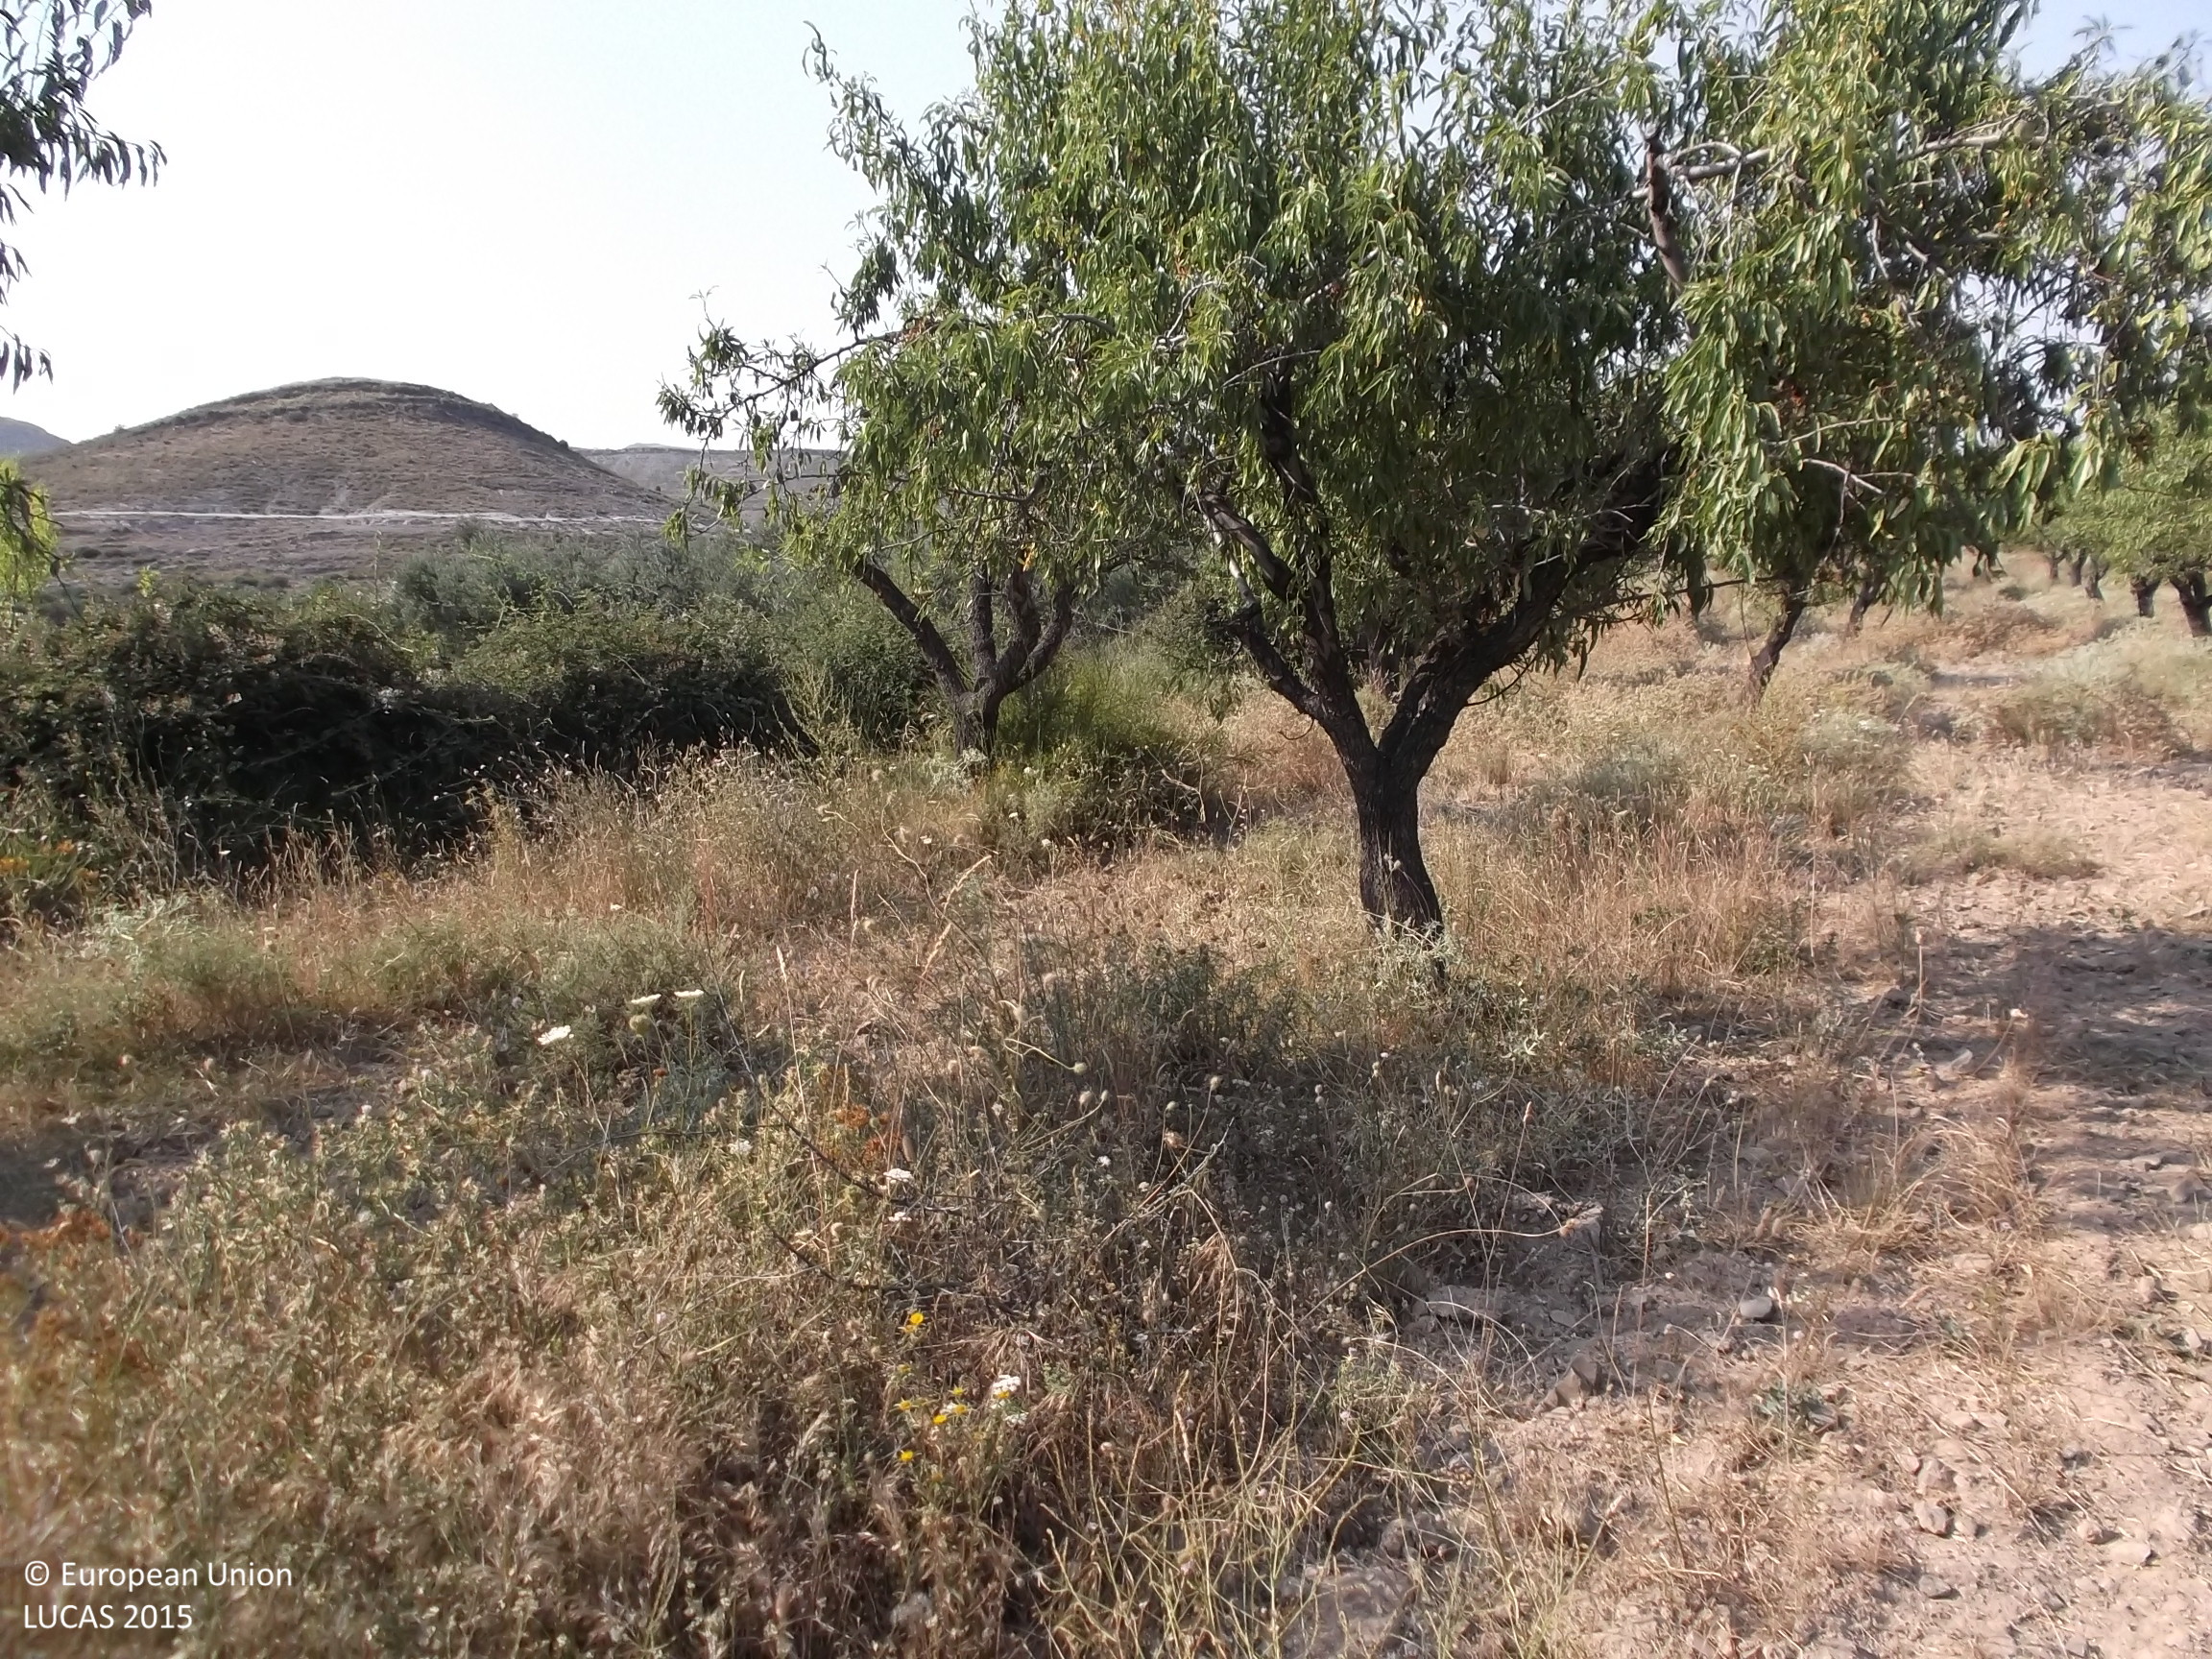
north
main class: Cropland
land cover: Nuts trees
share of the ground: 25 - 50 %
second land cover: Spontaneously vegetated surfaces
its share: > 75 %
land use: Agriculture (excluding fallow land and kitchen gardens)
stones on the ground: 10 - 25 %
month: July
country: ES
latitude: 42.0434
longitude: -2.0324
